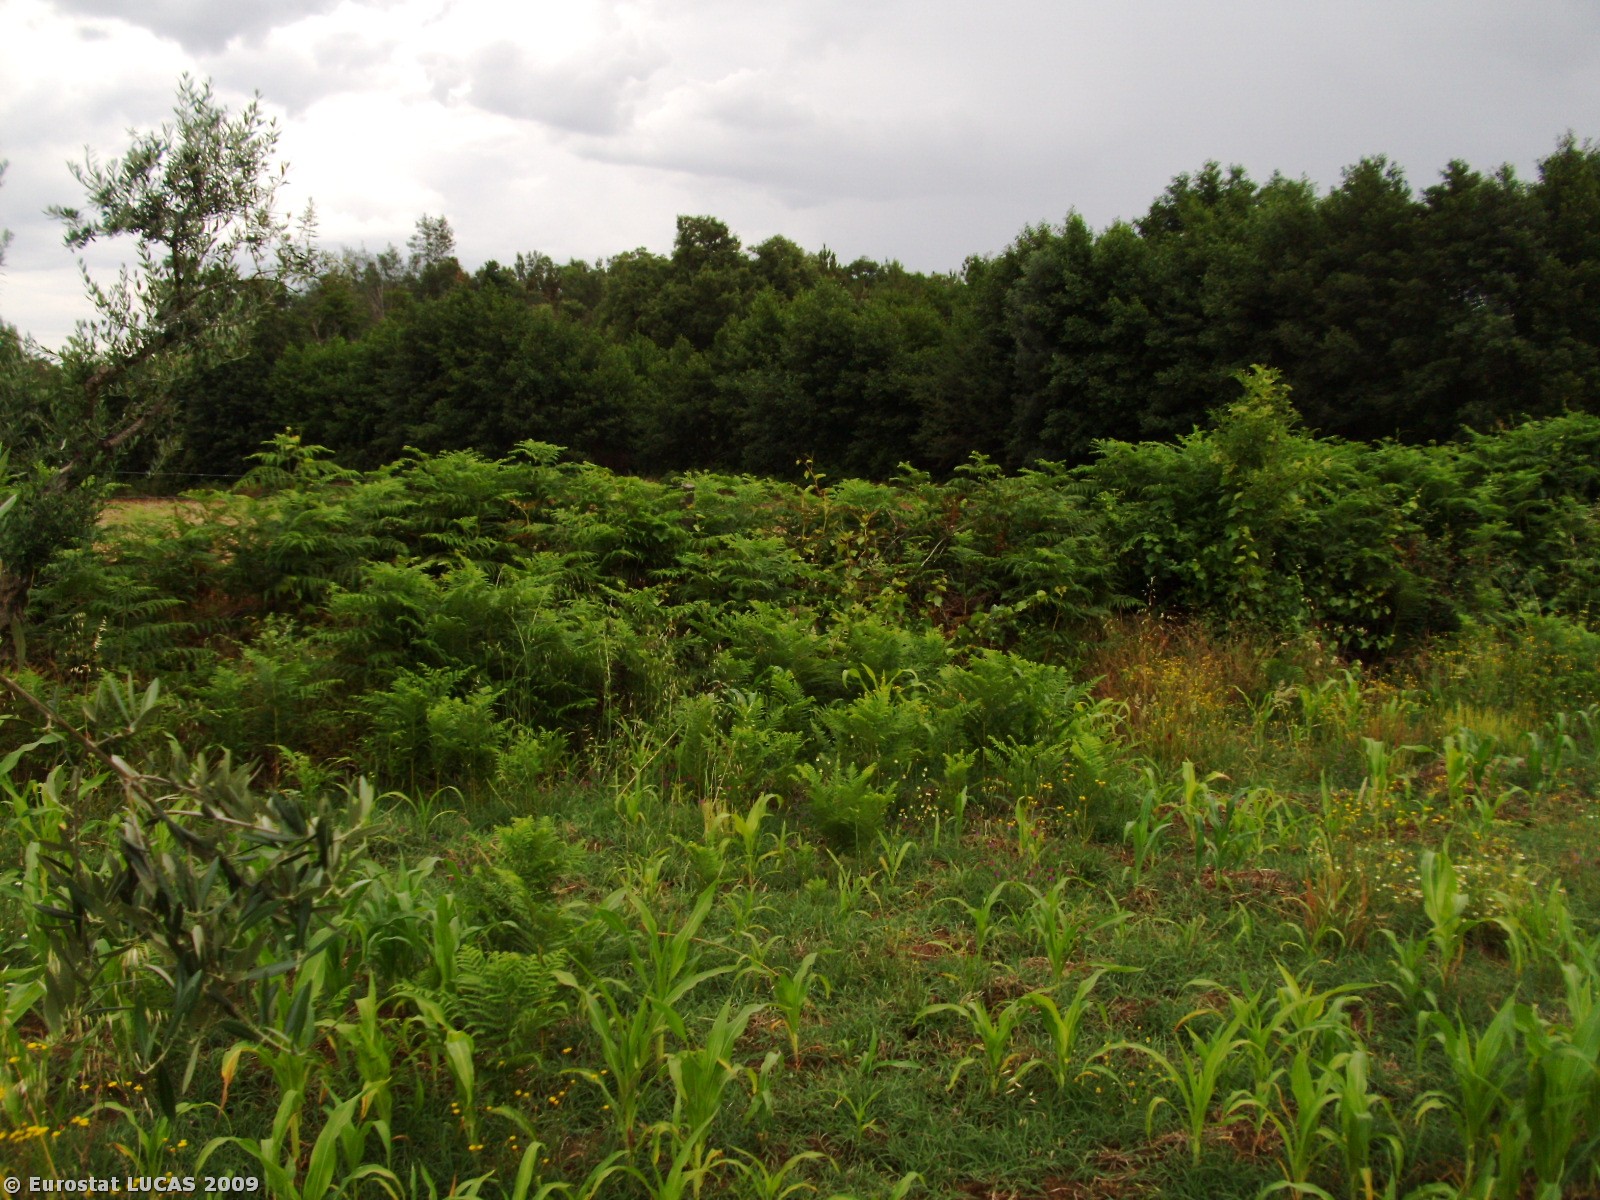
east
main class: Cropland
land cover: Olive groves
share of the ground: 25 - 50 %
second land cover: Maize
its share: 50 - 75 %
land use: Agriculture (excluding fallow land and kitchen gardens)
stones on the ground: > 50 %
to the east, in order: Olive groves; Maize; Olive groves; Abandoned hedges; Rivers and streams; Abandoned hedges; Spontaneously vegetated surfaces; Dry stone walls; Olive groves; Vineyards; Olive groves
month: June
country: PT
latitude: 39.9530
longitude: -7.5074
